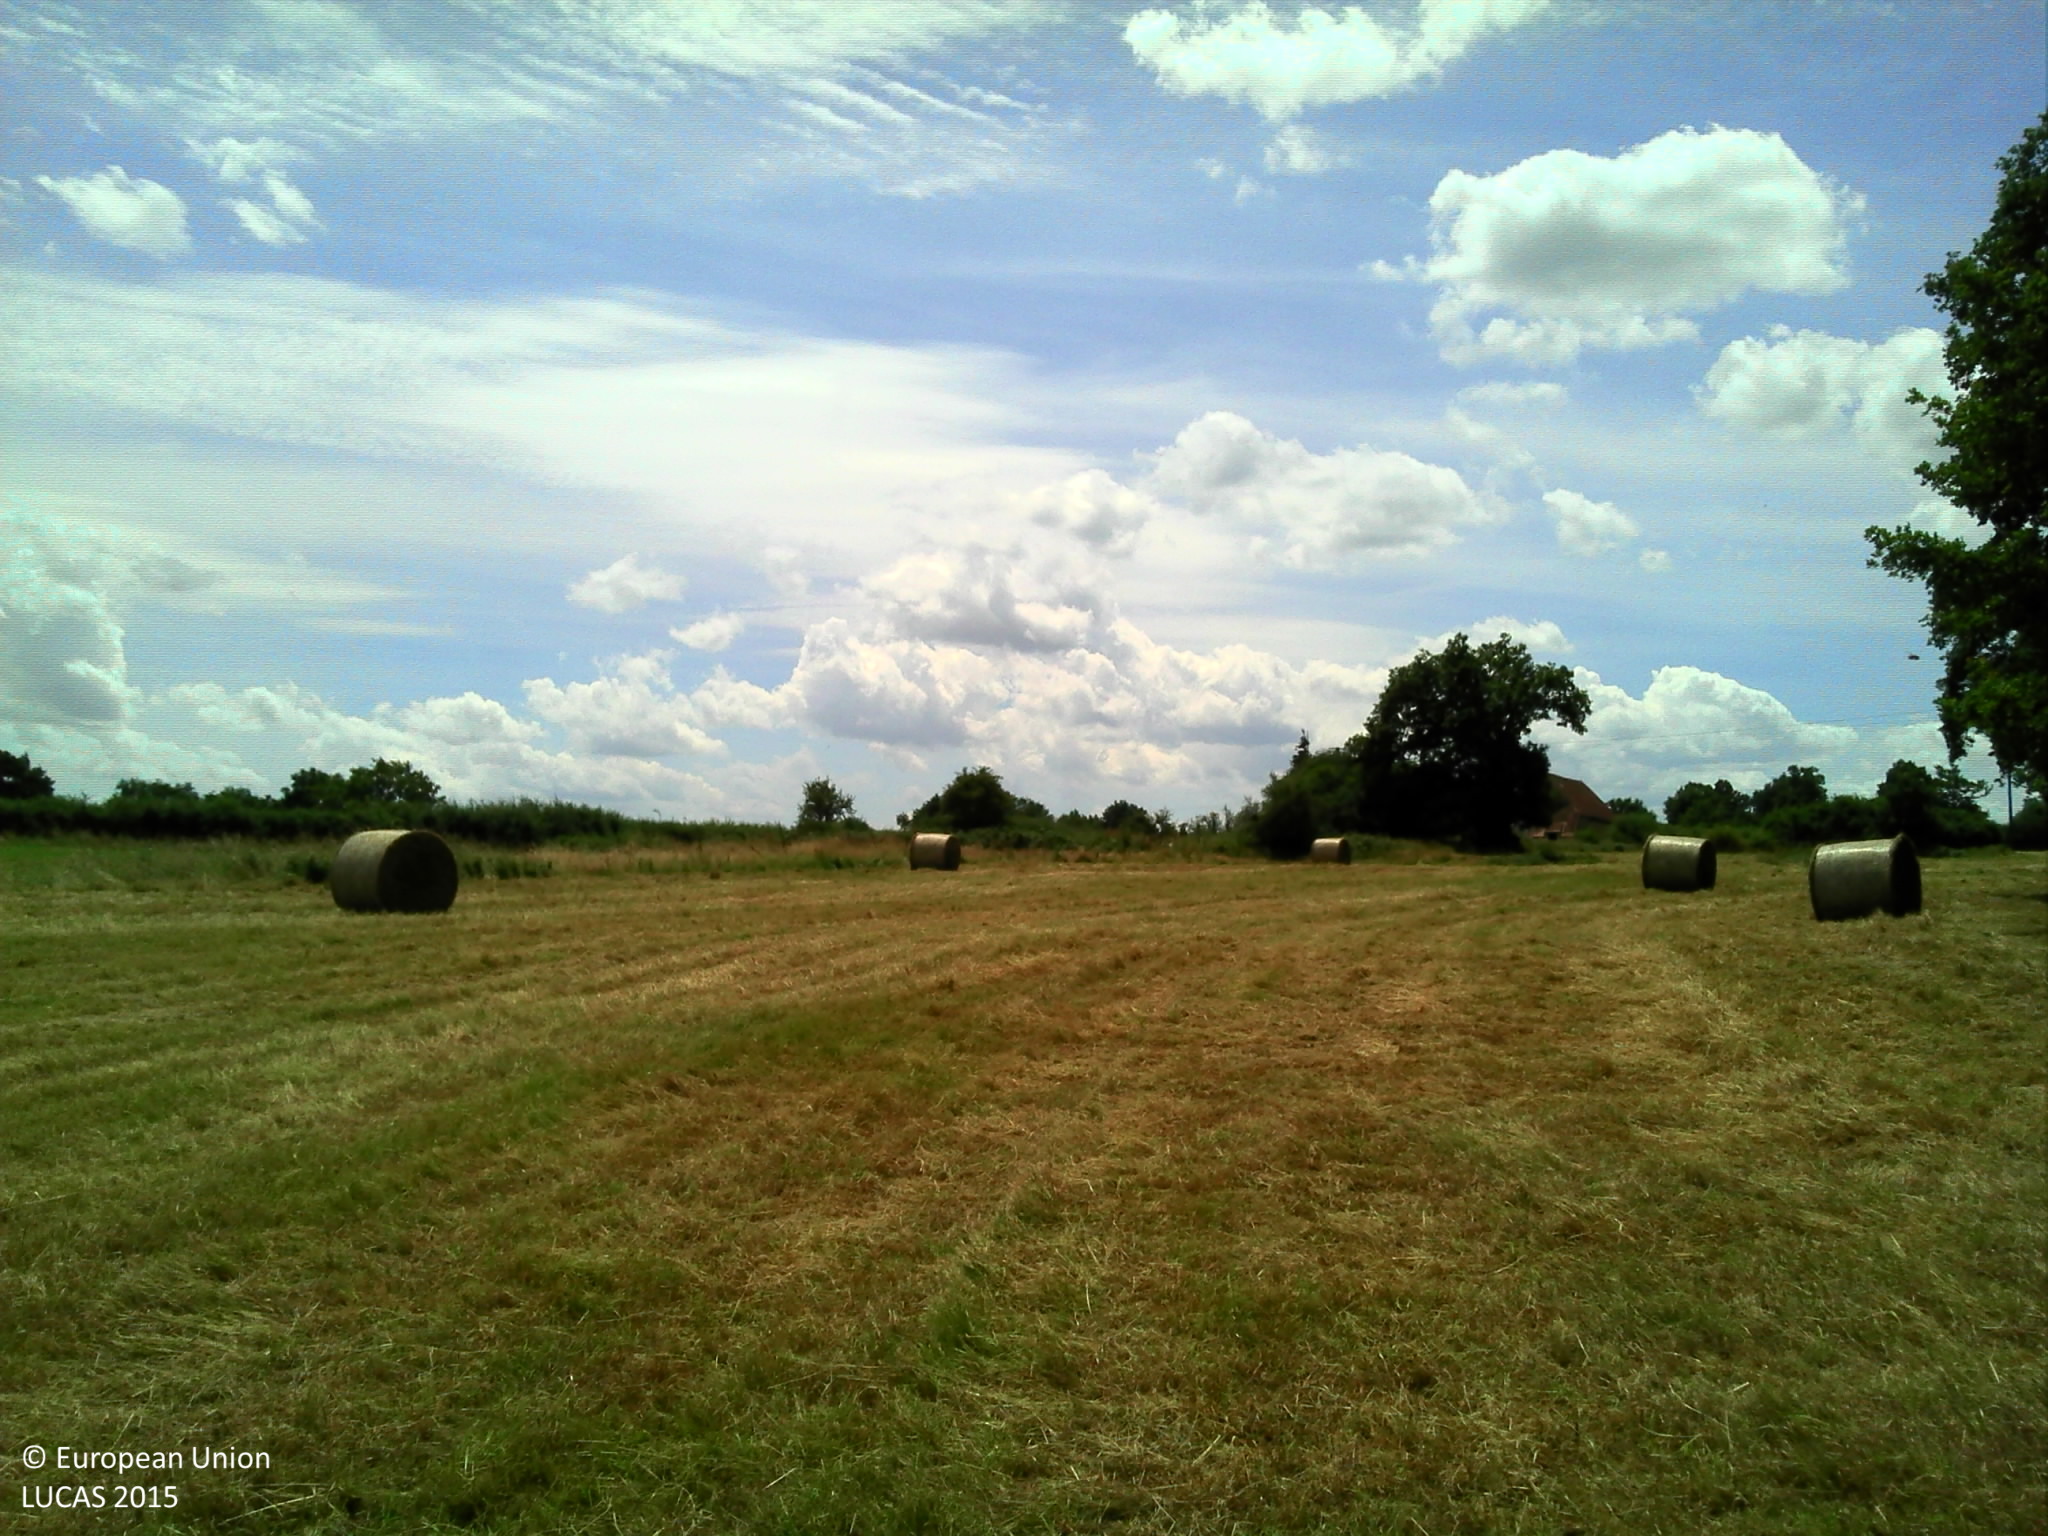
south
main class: Grassland
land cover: Grassland without tree/shrub cover
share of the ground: > 75 %
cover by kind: herbaceous plants 100 %
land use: Agriculture (excluding fallow land and kitchen gardens)
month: June
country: FR
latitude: 46.4267
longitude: 3.2446
